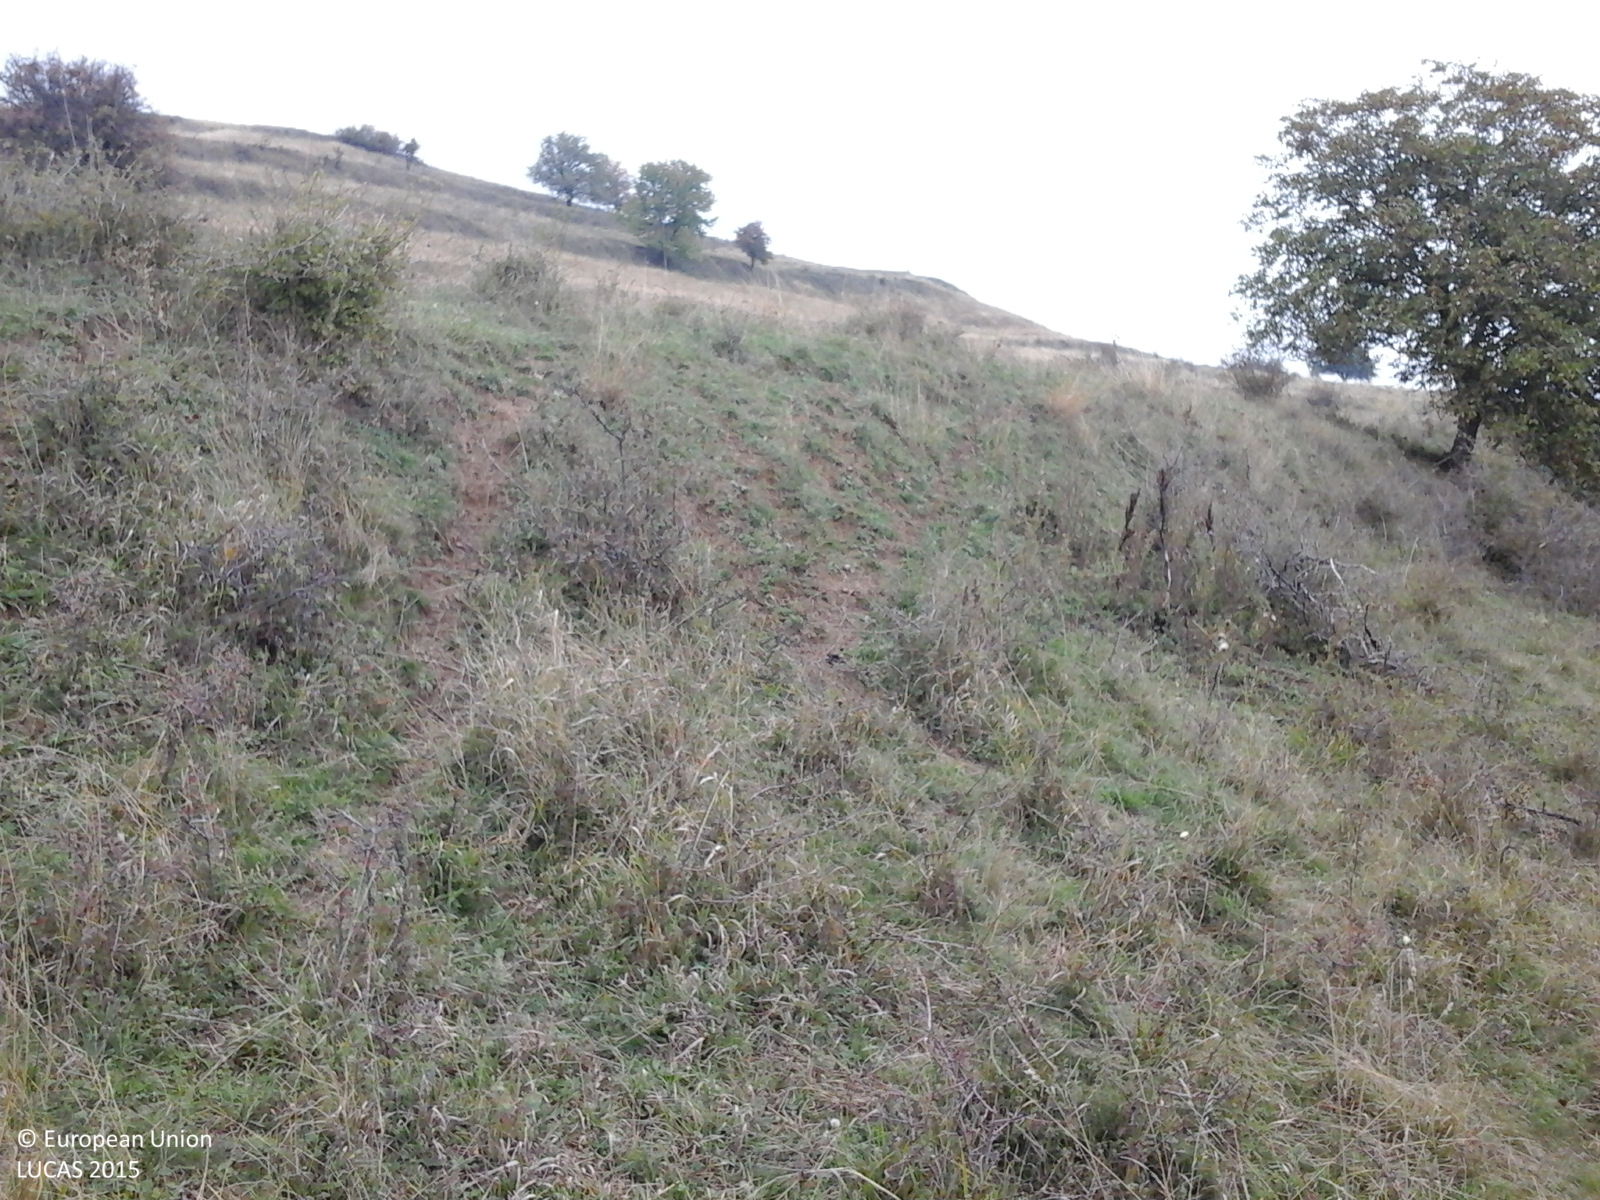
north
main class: Grassland
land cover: Grassland with sparse tree/shrub cover
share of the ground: > 75 %
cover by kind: herbaceous plants 85 %, shrubs 10 %, broadleaved forest trees 5 %
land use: Agriculture (excluding fallow land and kitchen gardens)
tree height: < 5 m
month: October
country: RO
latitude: 46.3201
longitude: 24.8068
